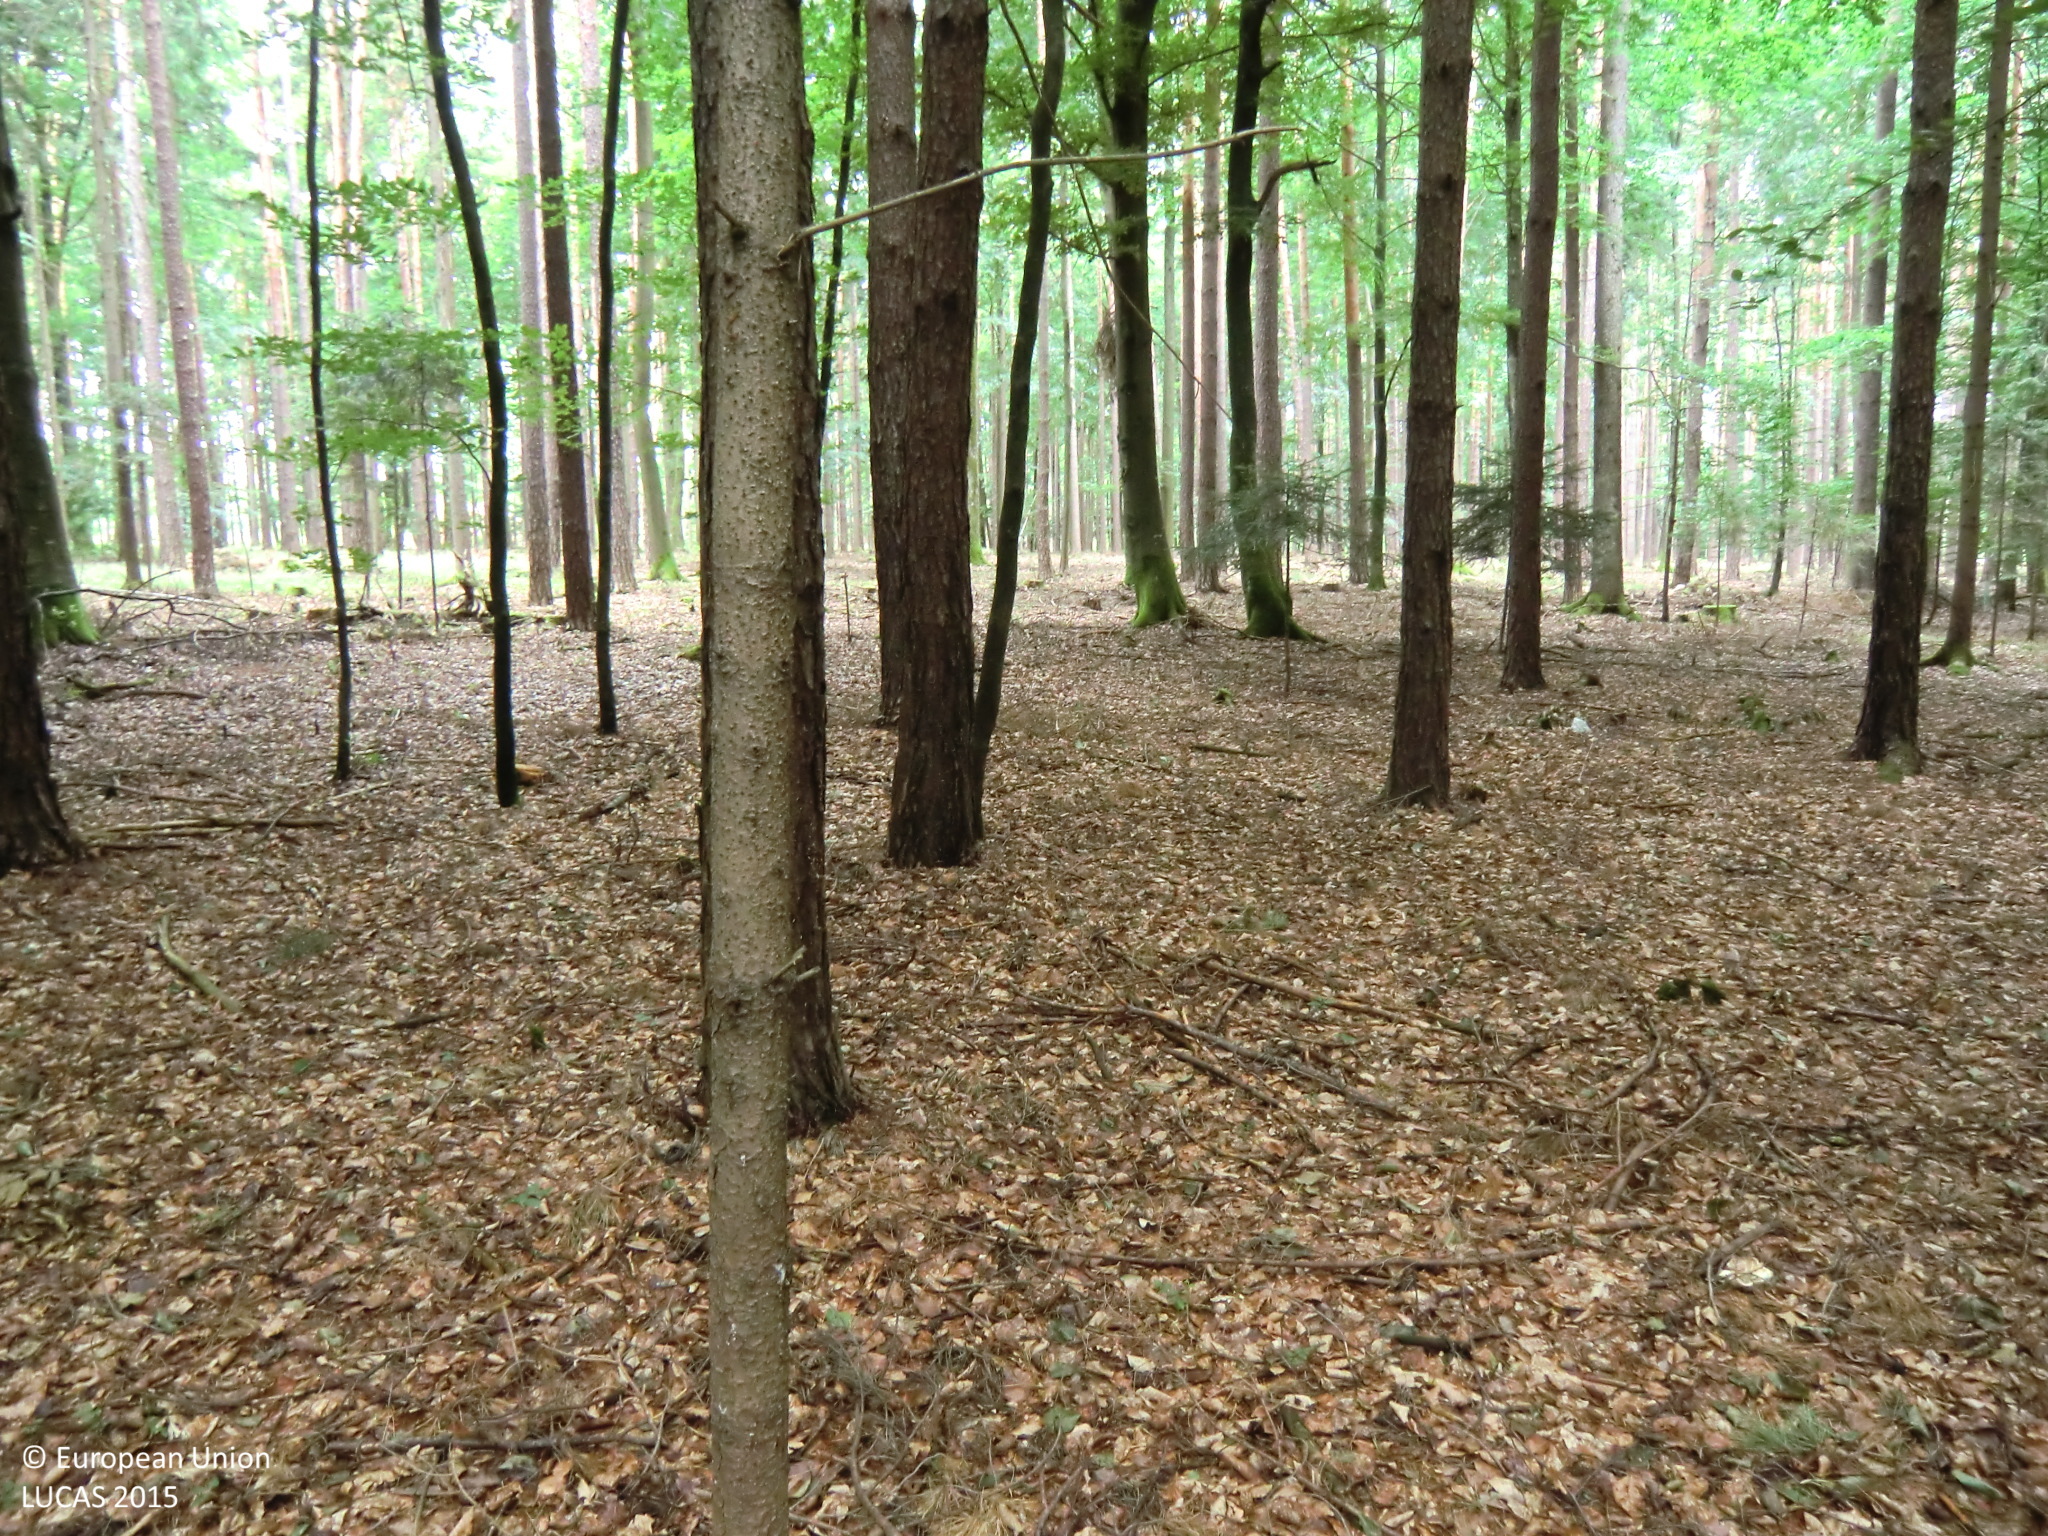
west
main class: Woodland
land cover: Other mixed woodland
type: hemiboreal forest and nemoral coniferous forest and mixed broadleaved-coniferous forest
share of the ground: > 75 %
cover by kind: coniferous forest trees 60 %, broadleaved forest trees 30 %, unconsolidated bare surface 10 %
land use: Forestry
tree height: > 5 m
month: June
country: AT
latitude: 47.2817
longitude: 16.0436
